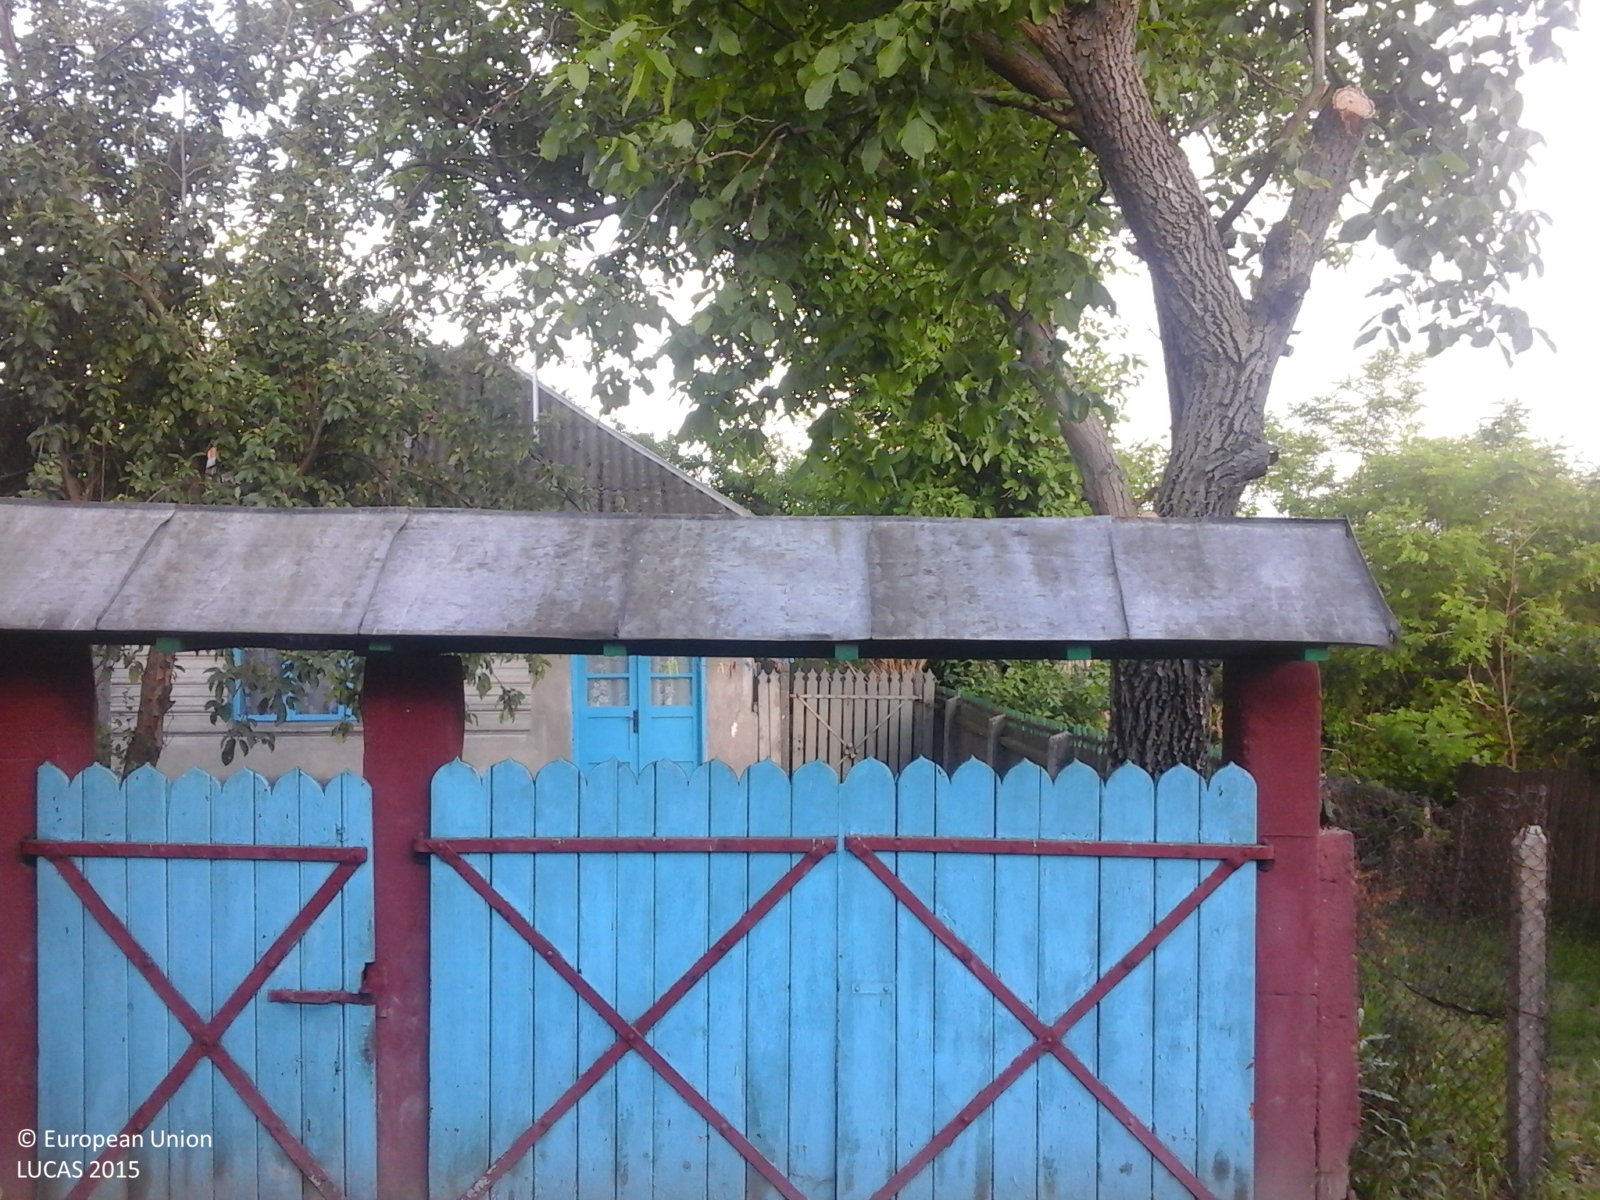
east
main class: Cropland
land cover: Other fresh vegetables
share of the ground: < 10 %
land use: Kitchen garden
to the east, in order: Other fresh vegetables; Artificial constructions in urban areas; Apple fruit; Arable land (only in case pi); Permanent crops (only in case pi); Other fresh vegetables; Artificial constructions in urban areas; Apple fruit
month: June
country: RO
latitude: 46.4292
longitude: 26.8926
